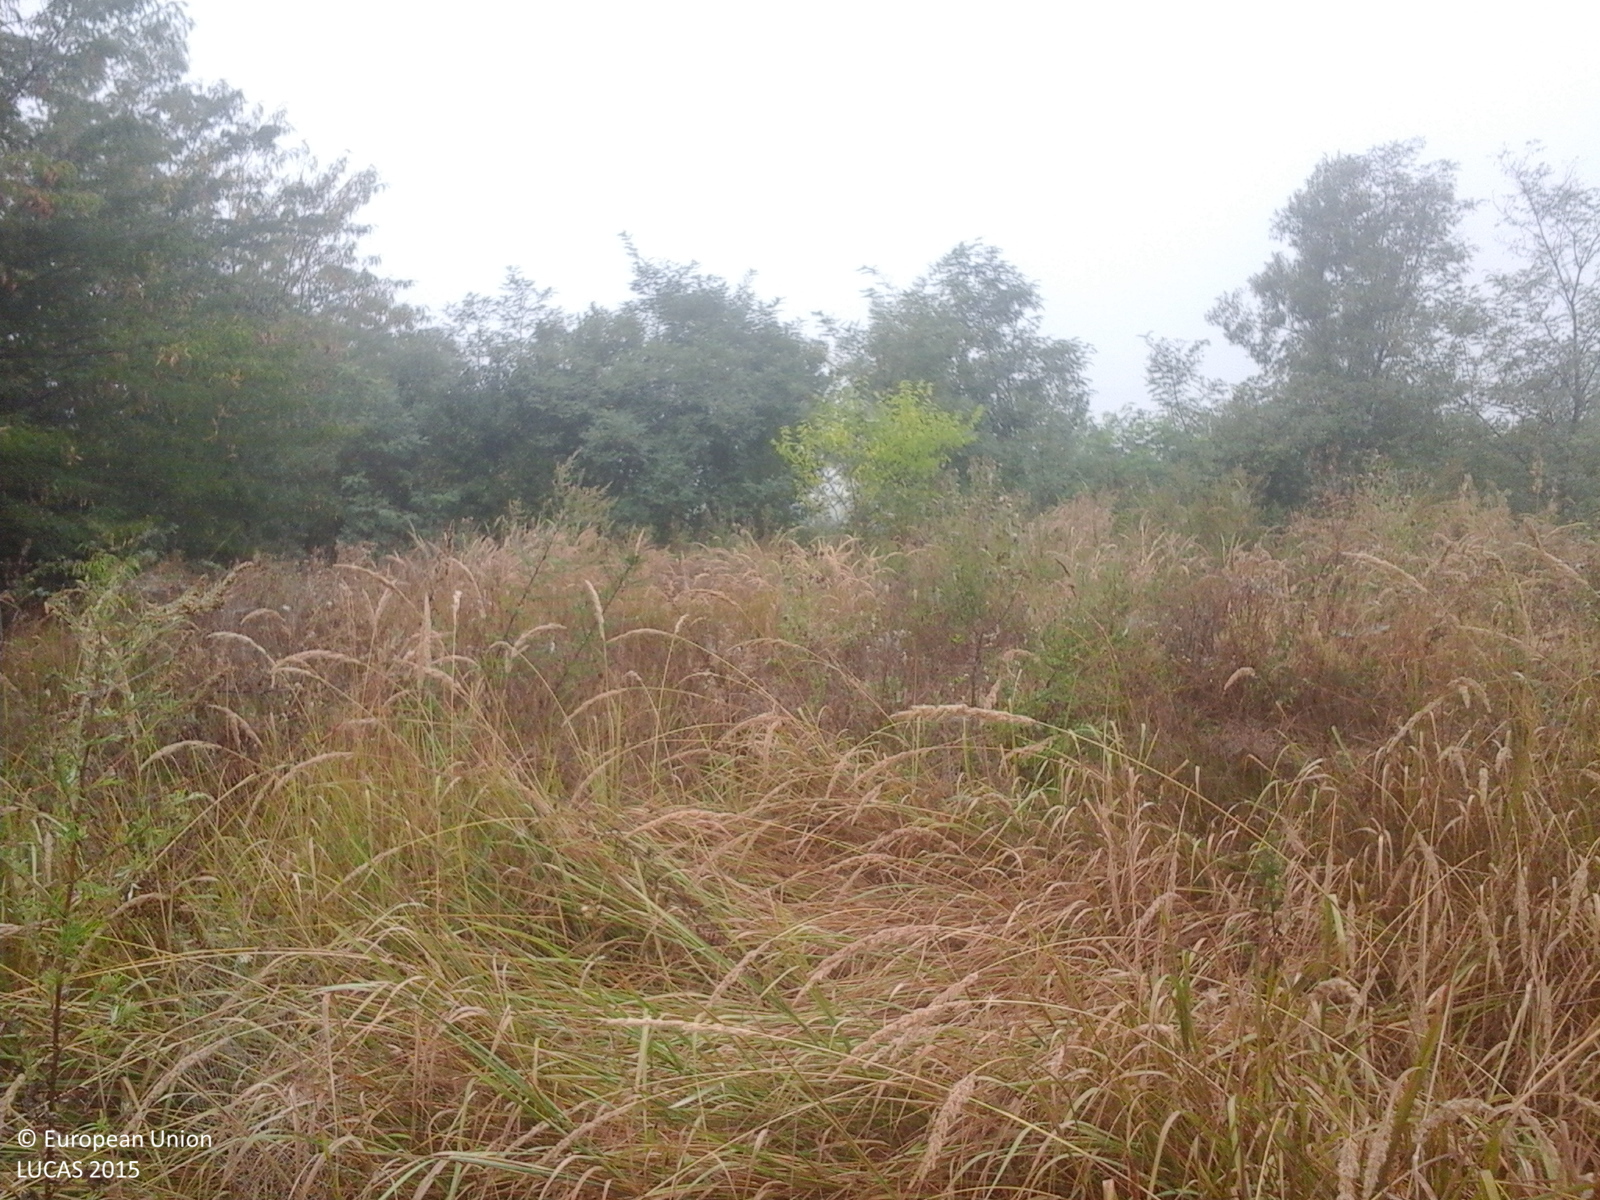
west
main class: Grassland
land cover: Spontaneously vegetated surfaces
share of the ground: > 75 %
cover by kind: herbaceous plants 100 %
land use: Fallow land
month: September
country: RO
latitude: 47.9580
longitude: 23.0176
